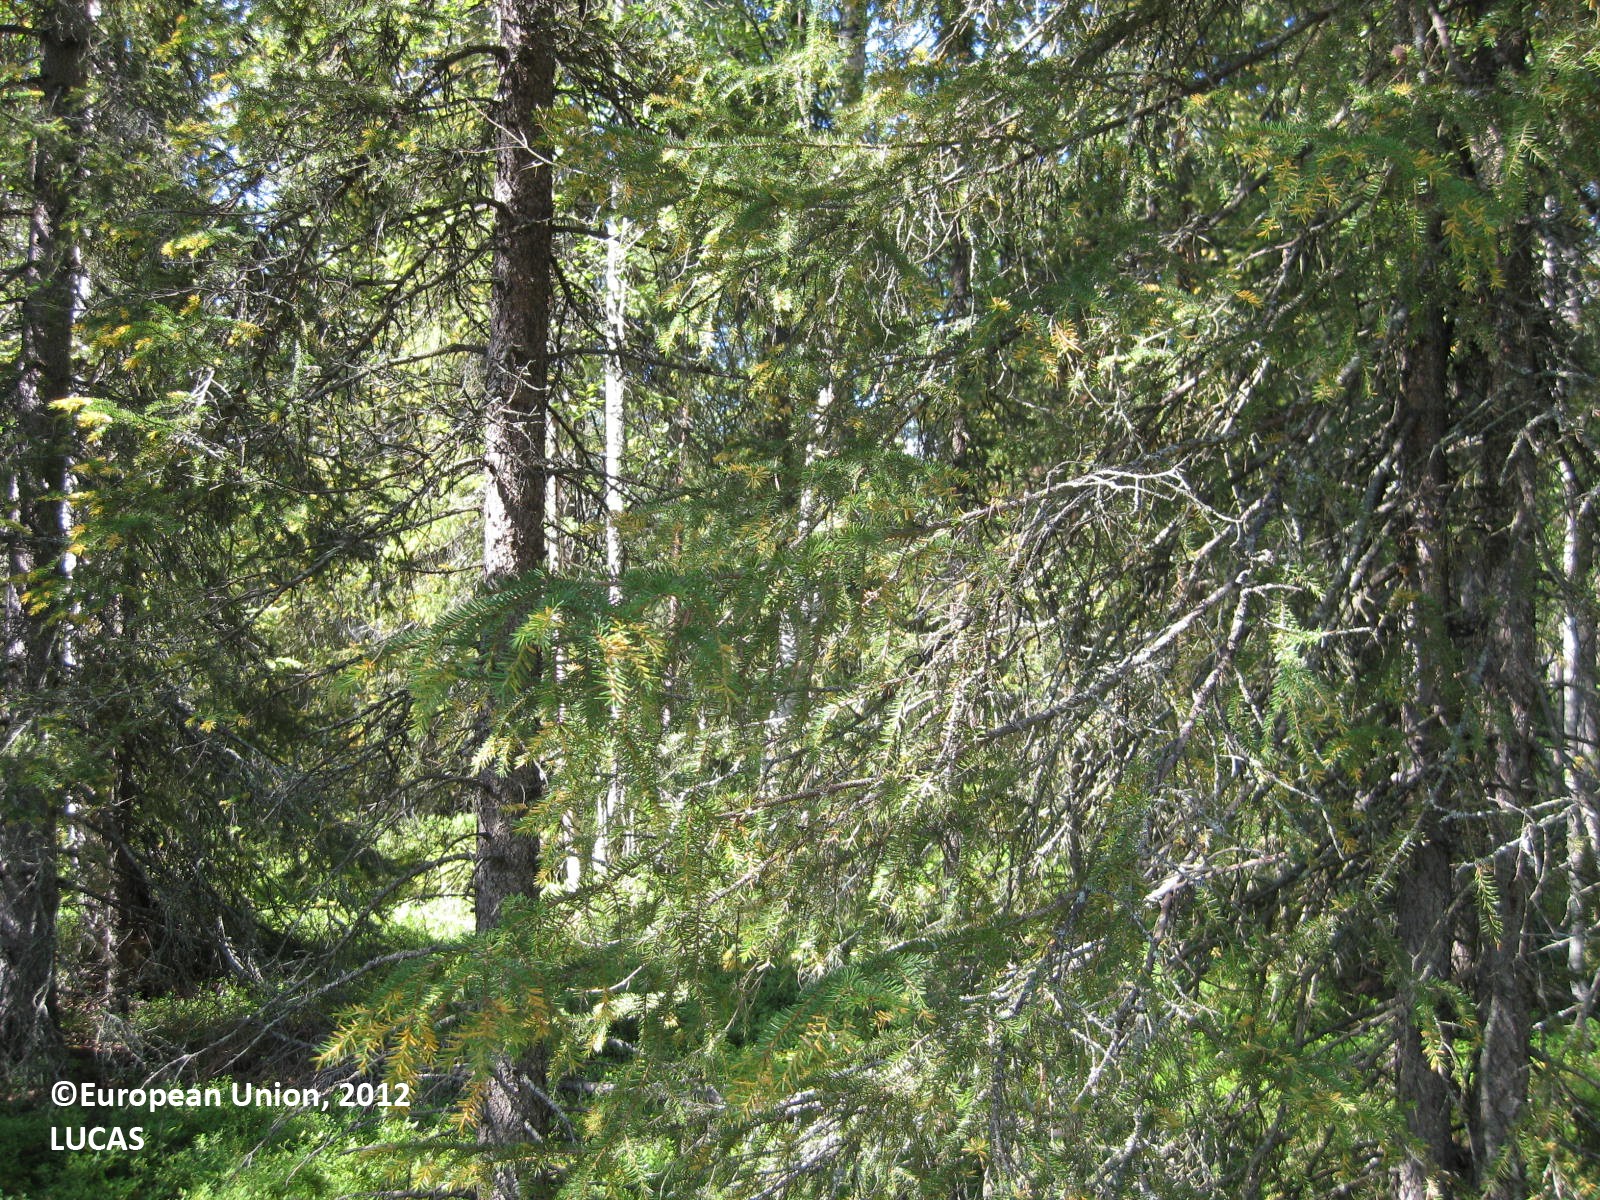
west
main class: Woodland
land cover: Other coniferous woodland
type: boreal forest
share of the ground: > 75 %
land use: Forestry
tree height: > 5 m
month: August
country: FI
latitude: 66.3557
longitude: 29.0489
